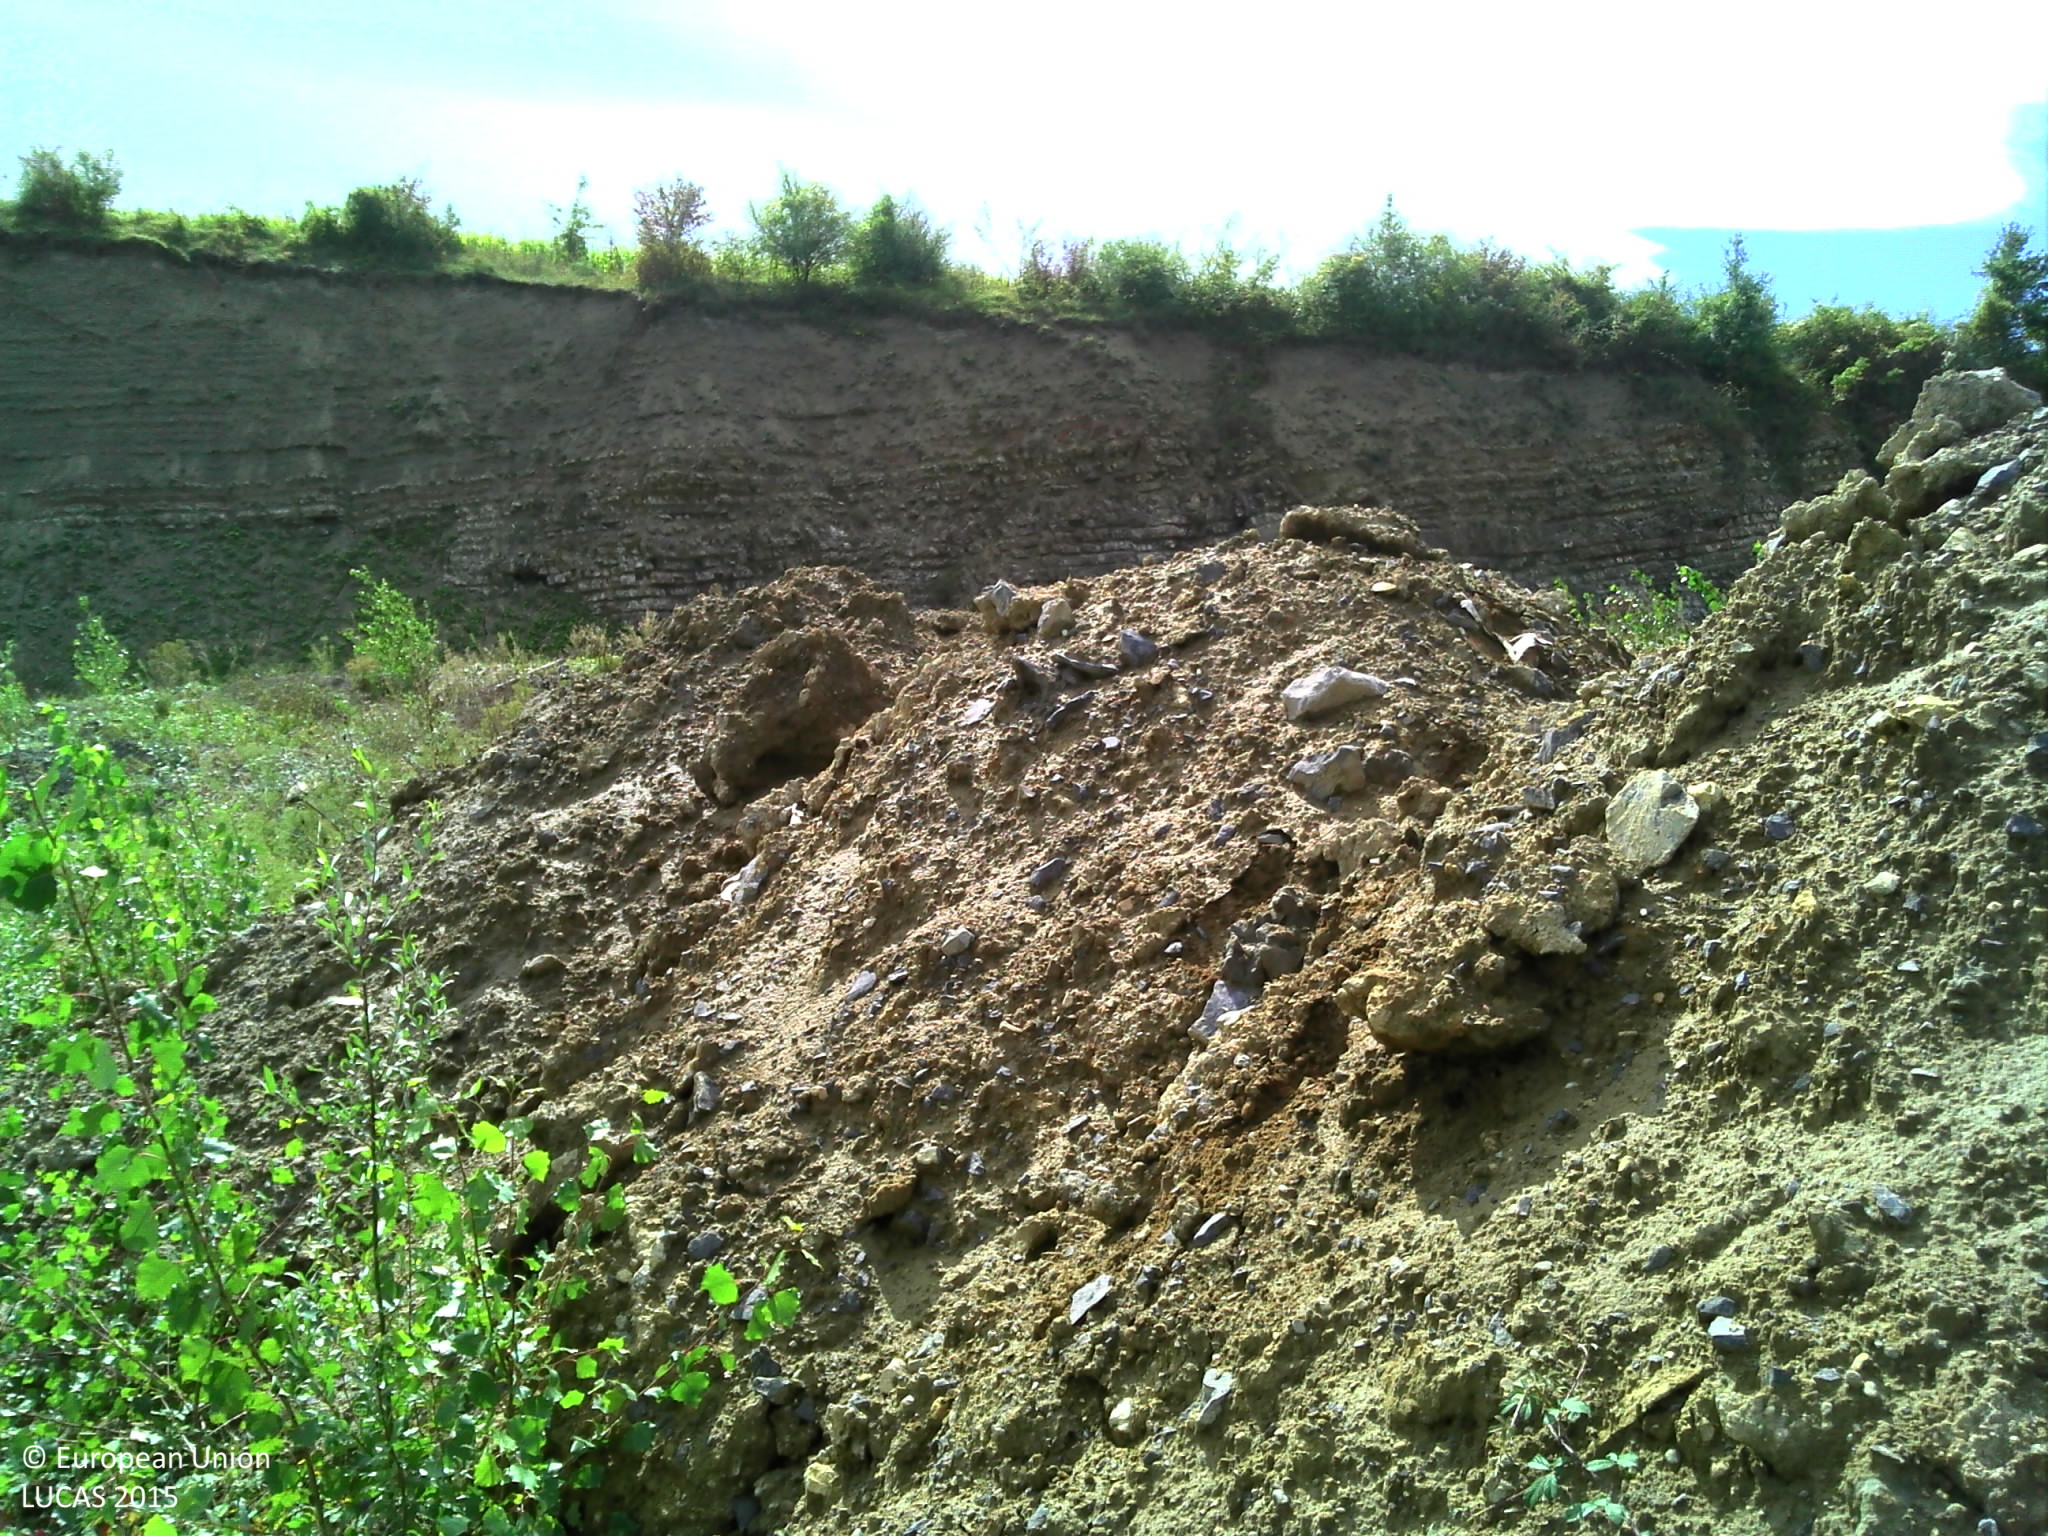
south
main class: Shrubland
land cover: Shrubland with sparse tree cover
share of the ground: > 75 %
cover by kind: shrubs 40 %, unconsolidated bare surface 30 %, herbaceous plants 20 %, broadleaved forest trees 5 %, consolidated bare surface 5 %
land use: Abandoned areas
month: September
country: FR
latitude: 43.4273
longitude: -0.7453
